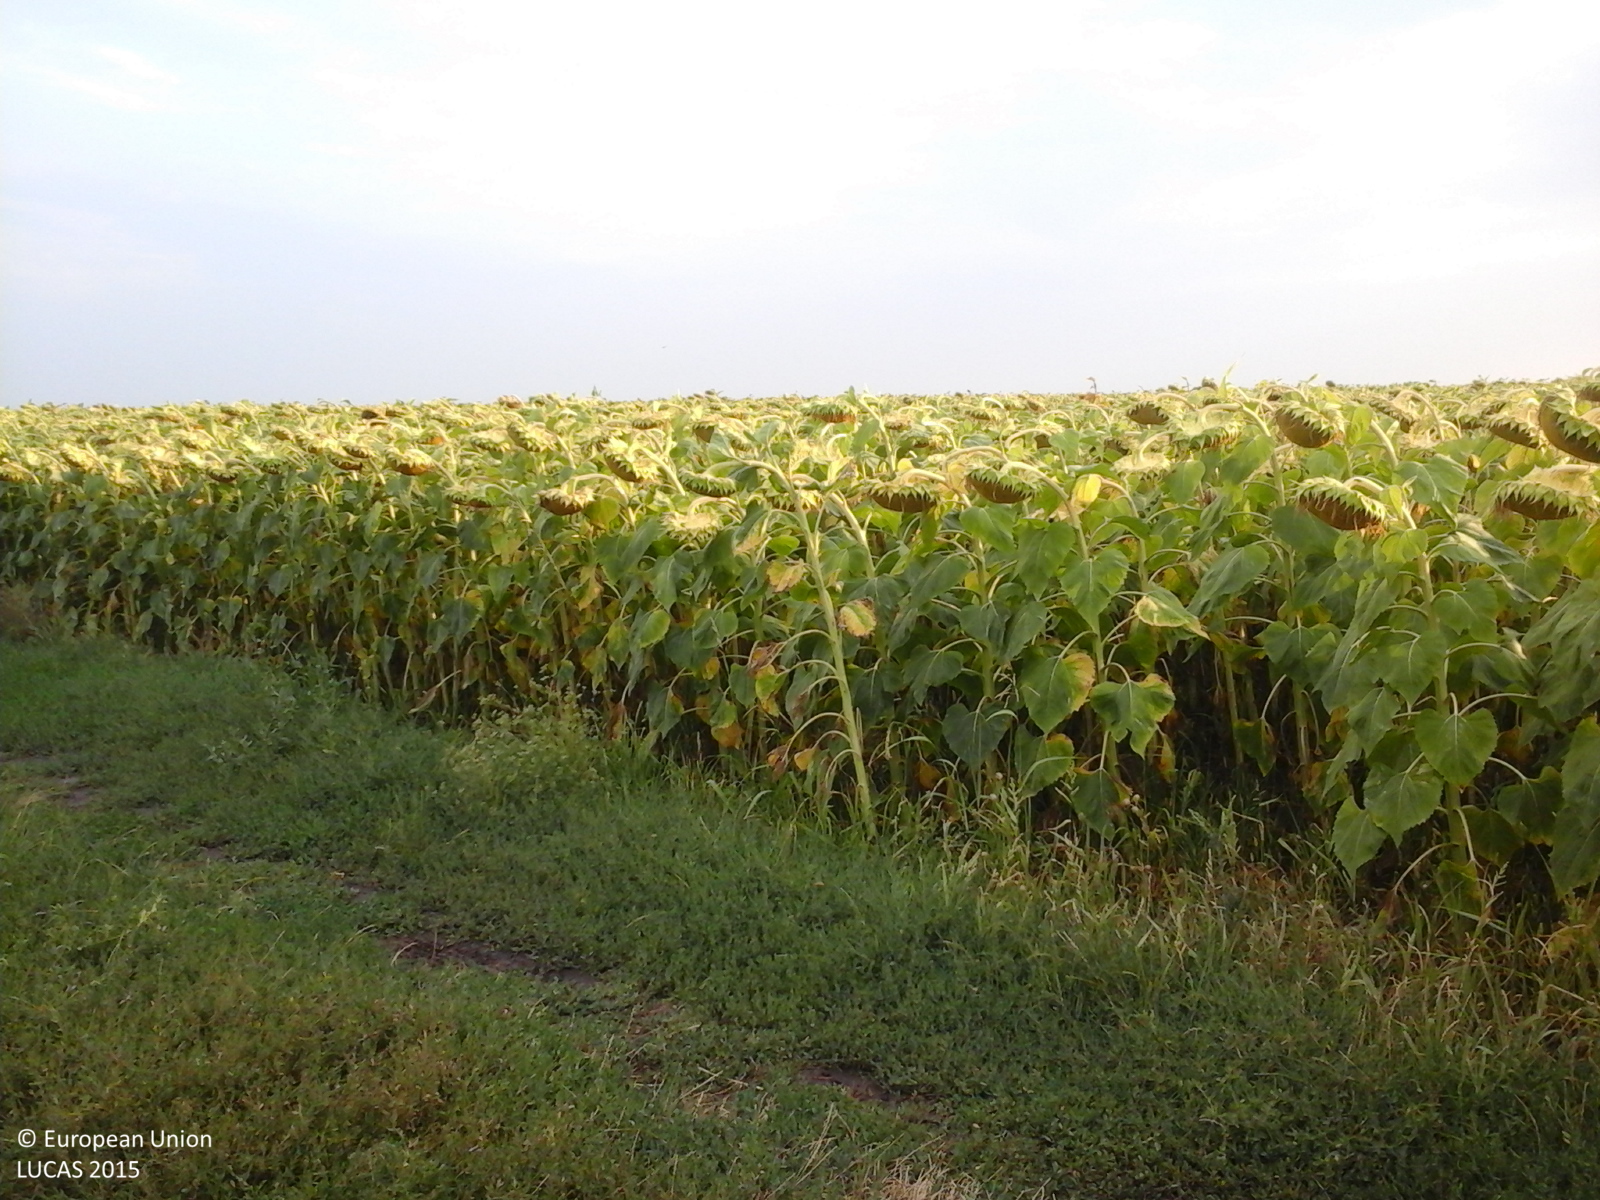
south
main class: Cropland
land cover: Soya
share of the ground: > 75 %
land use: Agriculture (excluding fallow land and kitchen gardens)
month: August
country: RO
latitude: 45.0624
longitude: 27.4836
